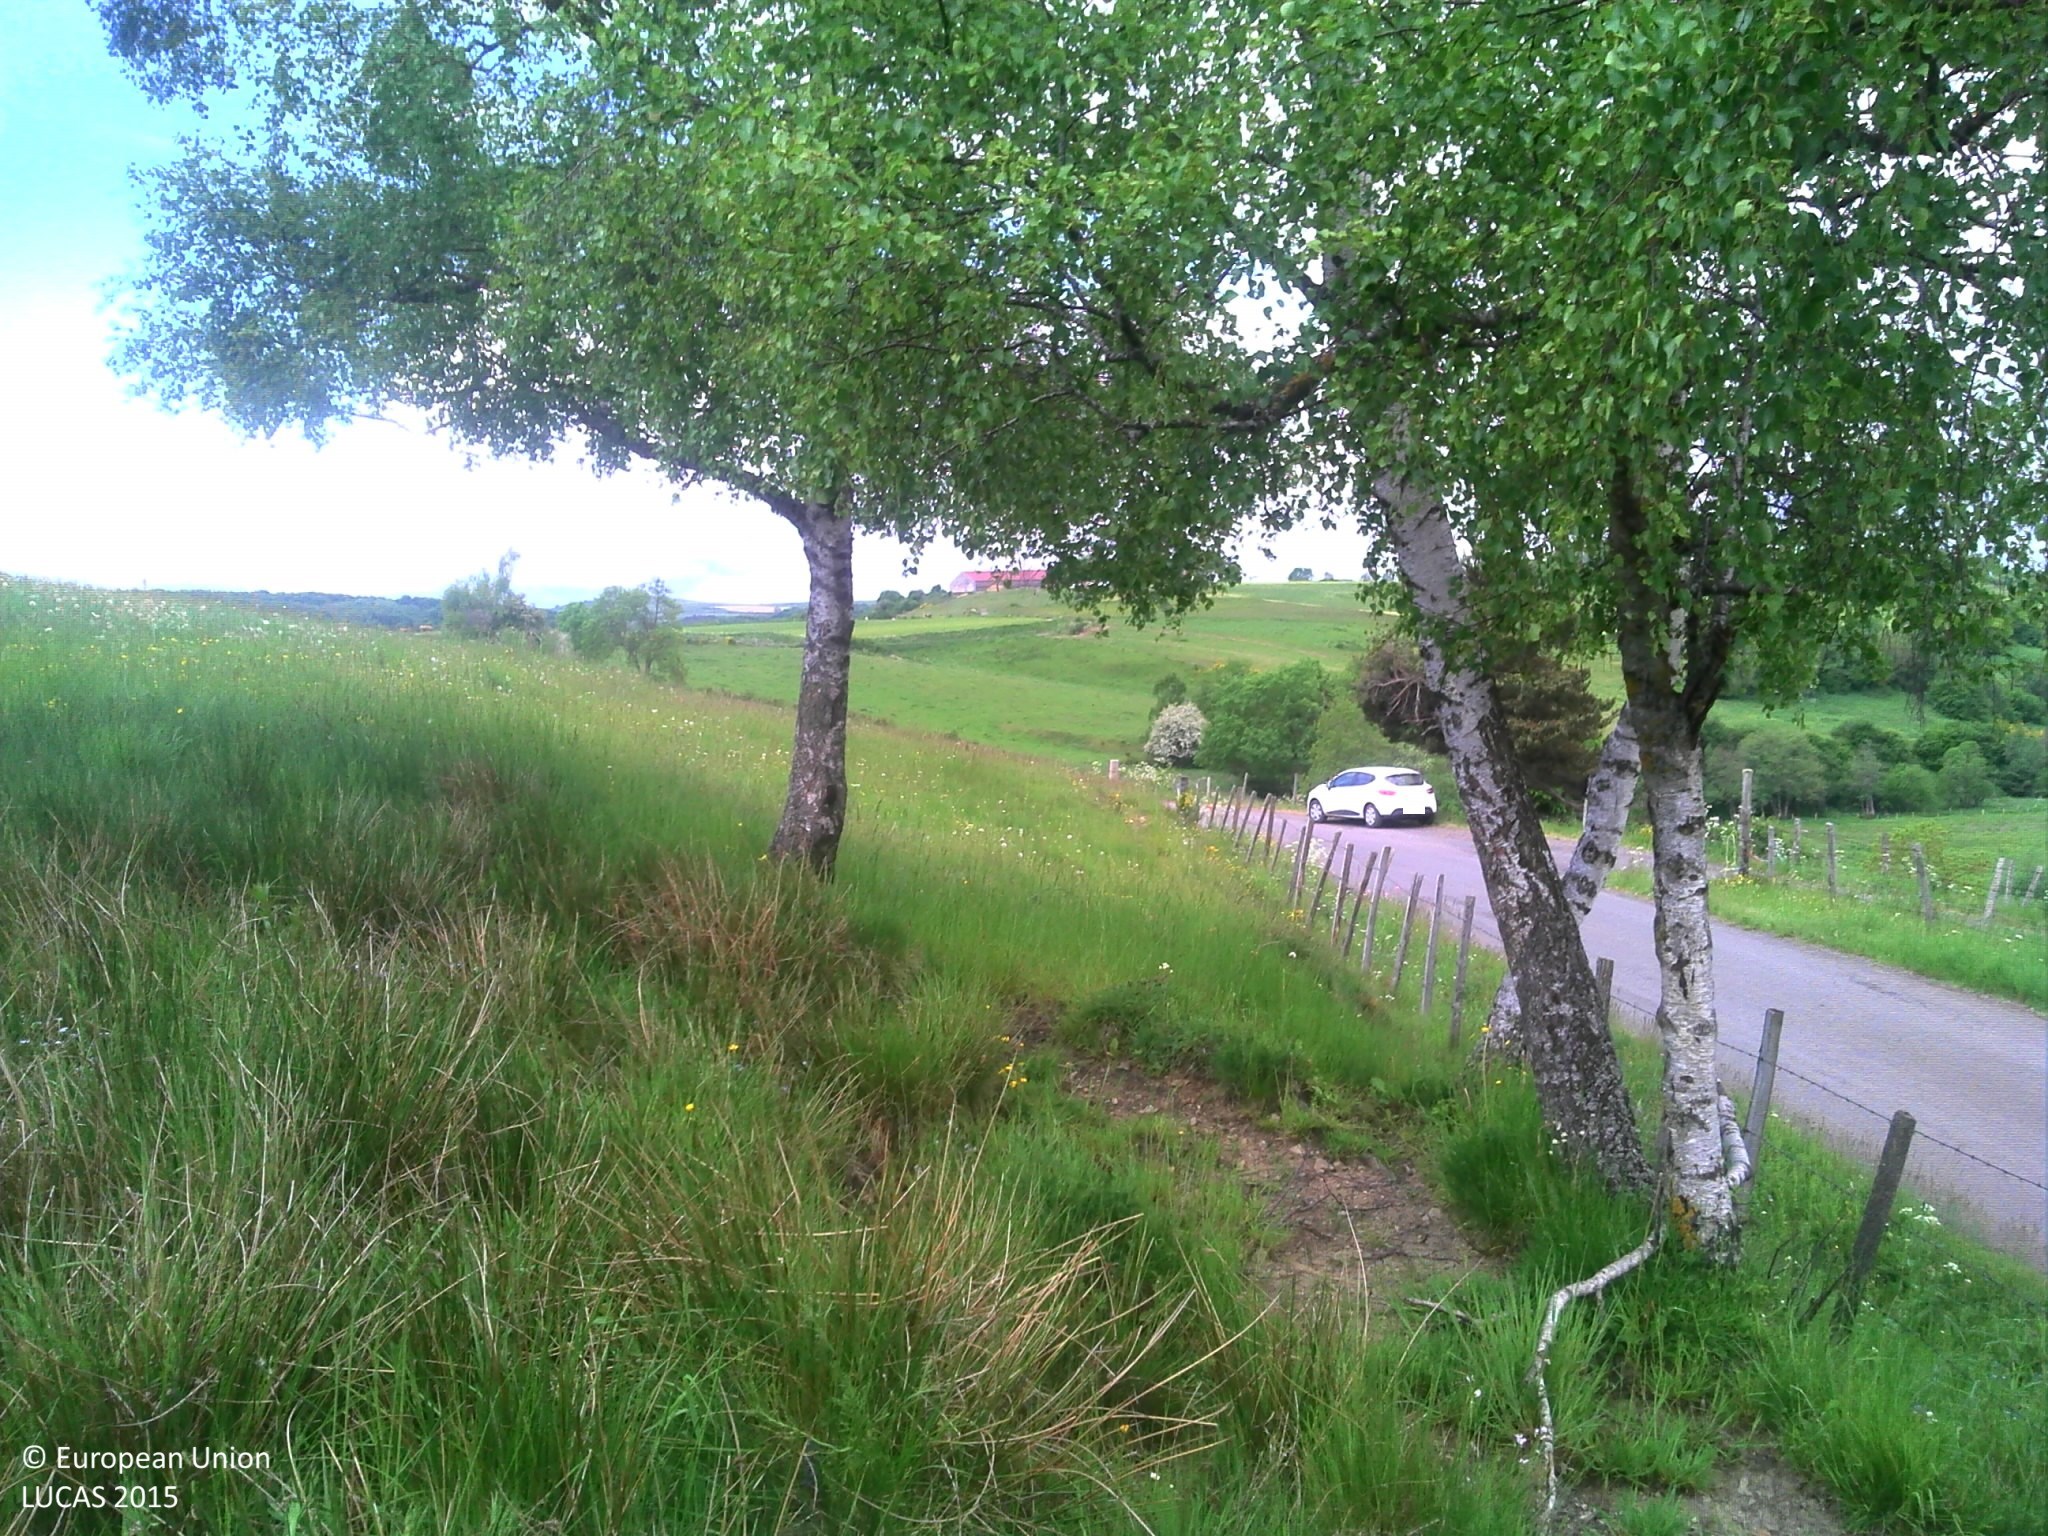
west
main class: Grassland
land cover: Grassland with sparse tree/shrub cover
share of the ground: > 75 %
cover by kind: herbaceous plants 95 %, broadleaved forest trees 5 %
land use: Agriculture (excluding fallow land and kitchen gardens)
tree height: > 5 m
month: June
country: FR
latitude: 45.1207
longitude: 3.1755
